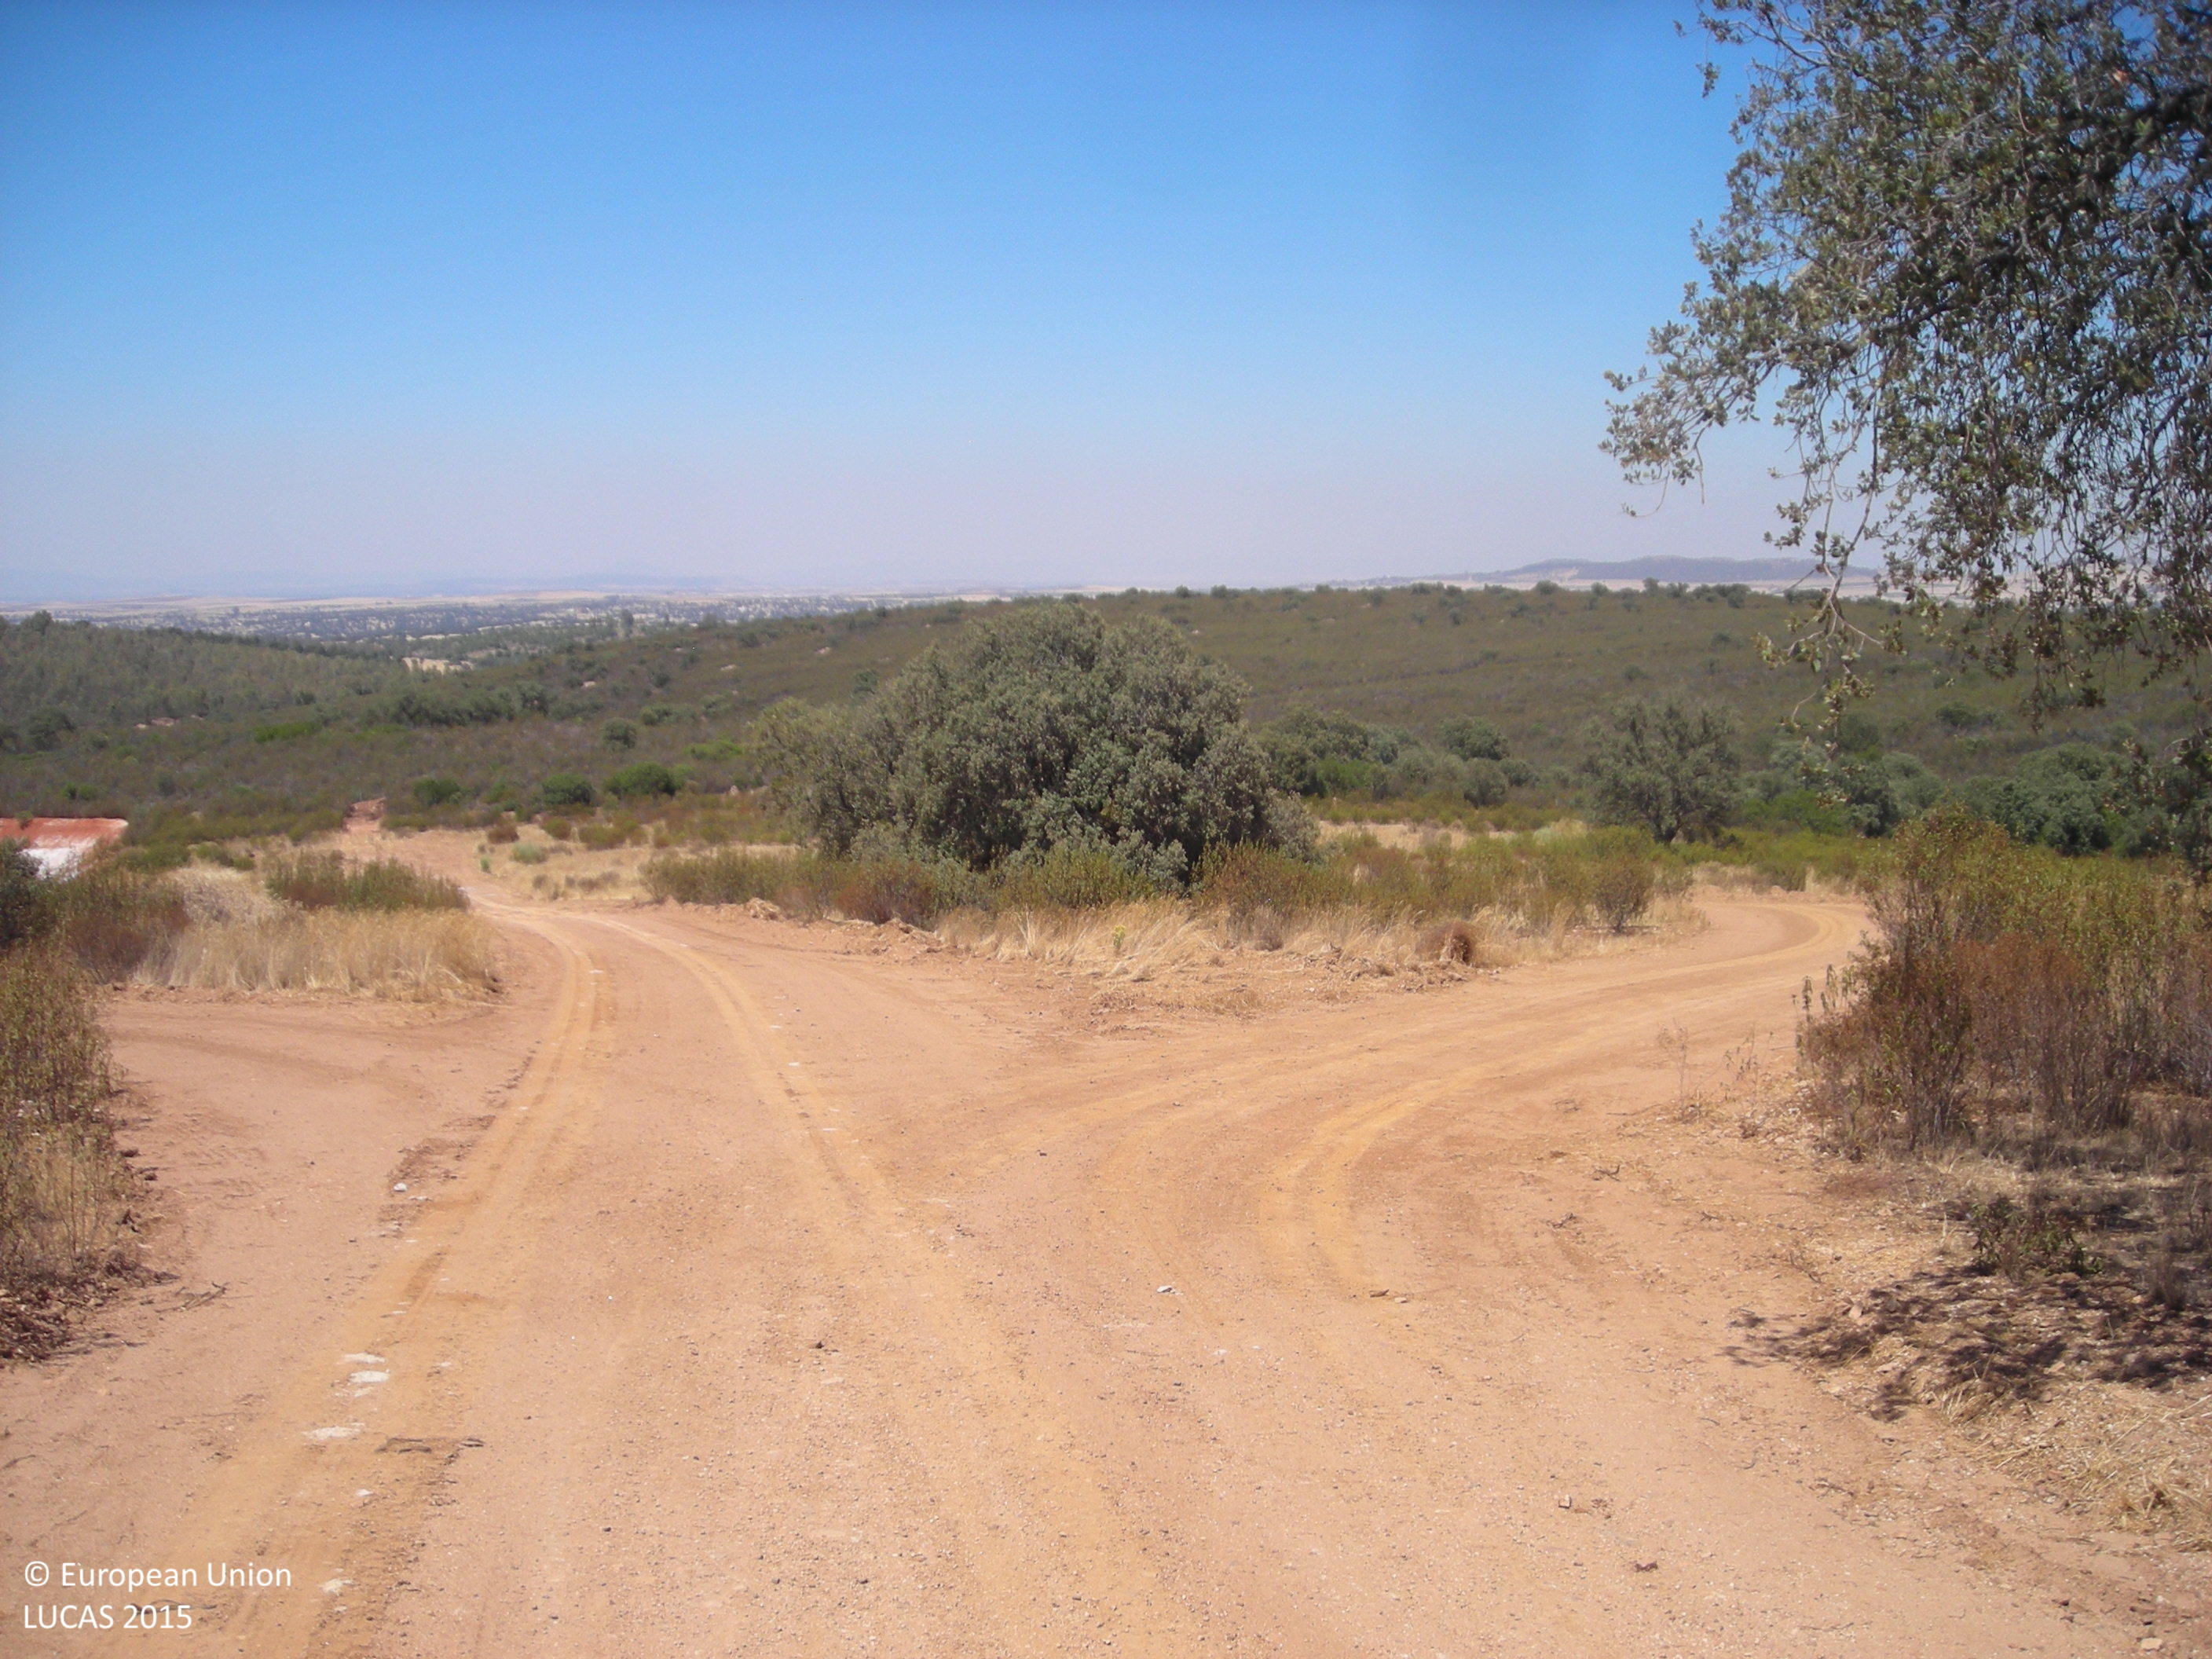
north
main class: Shrubland
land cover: Shrubland with sparse tree cover
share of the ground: > 75 %
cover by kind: shrubs 95 %, broadleaved forest trees 5 %
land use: Semi-natural and natural areas not in use
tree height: > 5 m
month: July
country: ES
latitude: 38.8104
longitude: -5.8114
